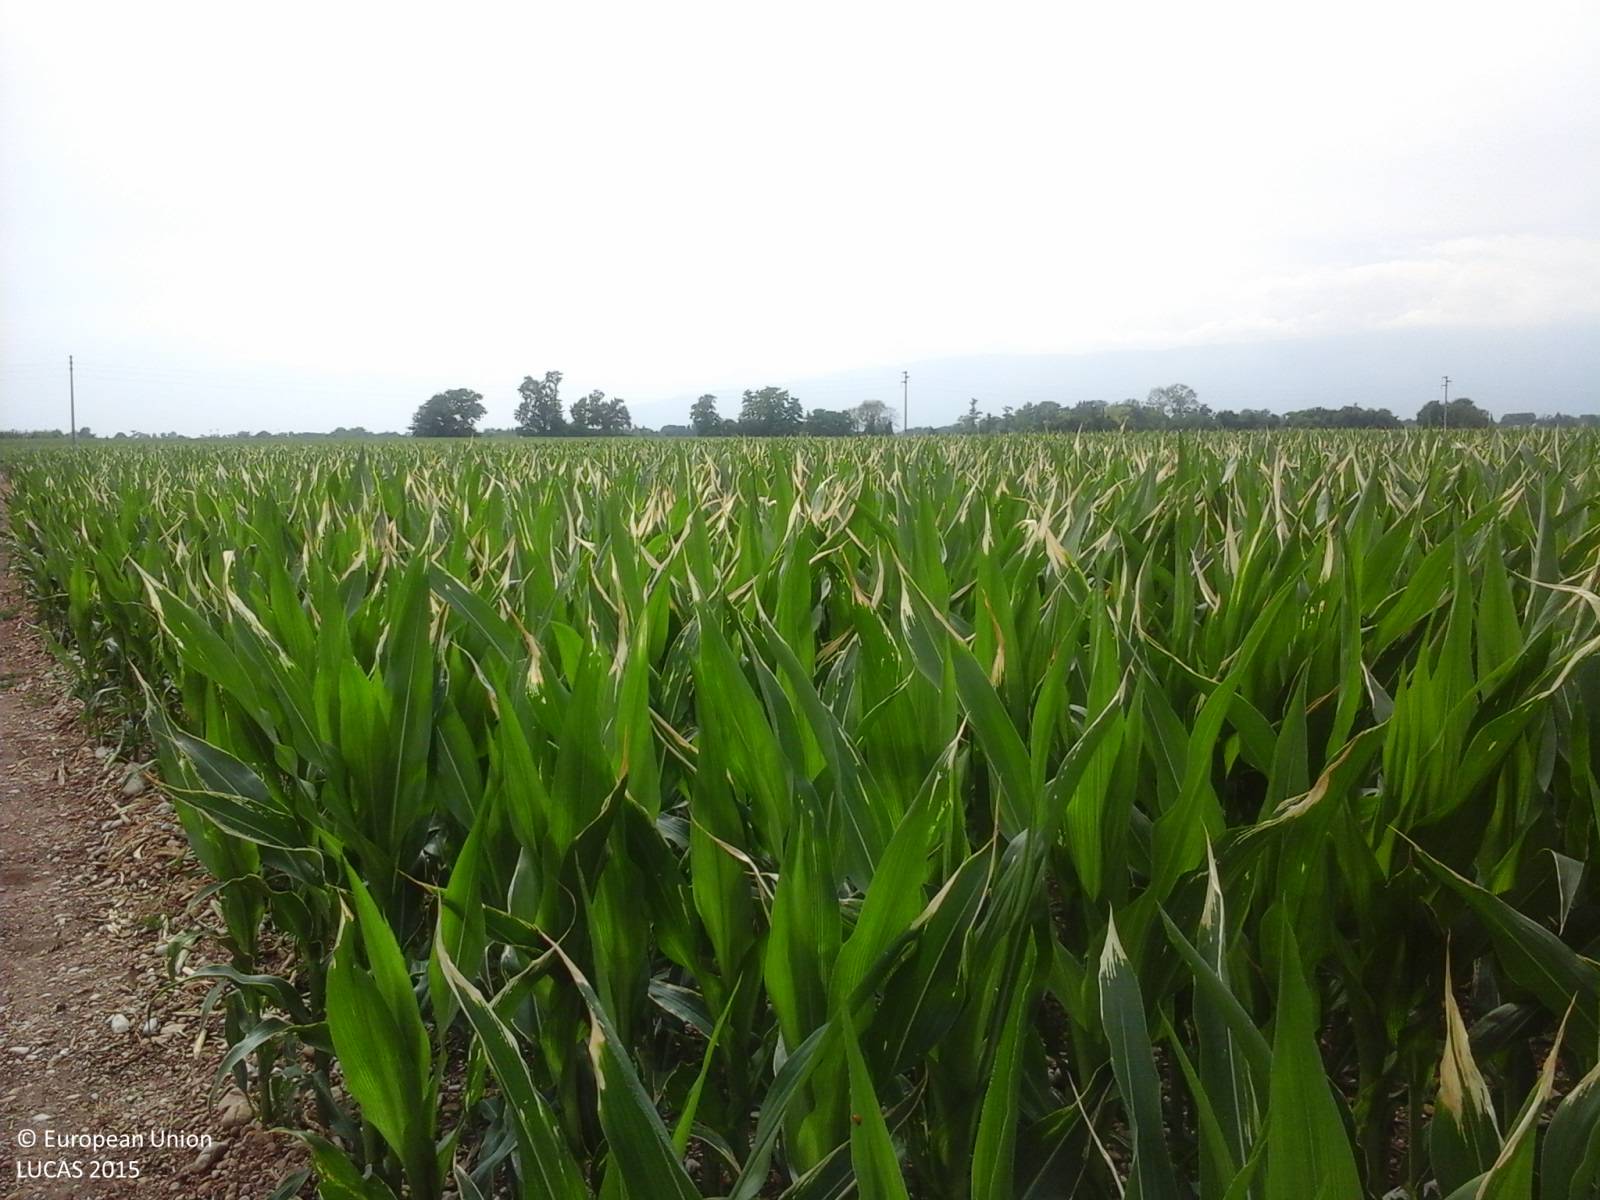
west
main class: Cropland
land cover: Maize
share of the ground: > 75 %
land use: Agriculture (excluding fallow land and kitchen gardens)
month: June
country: IT
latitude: 46.0108
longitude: 12.6959
